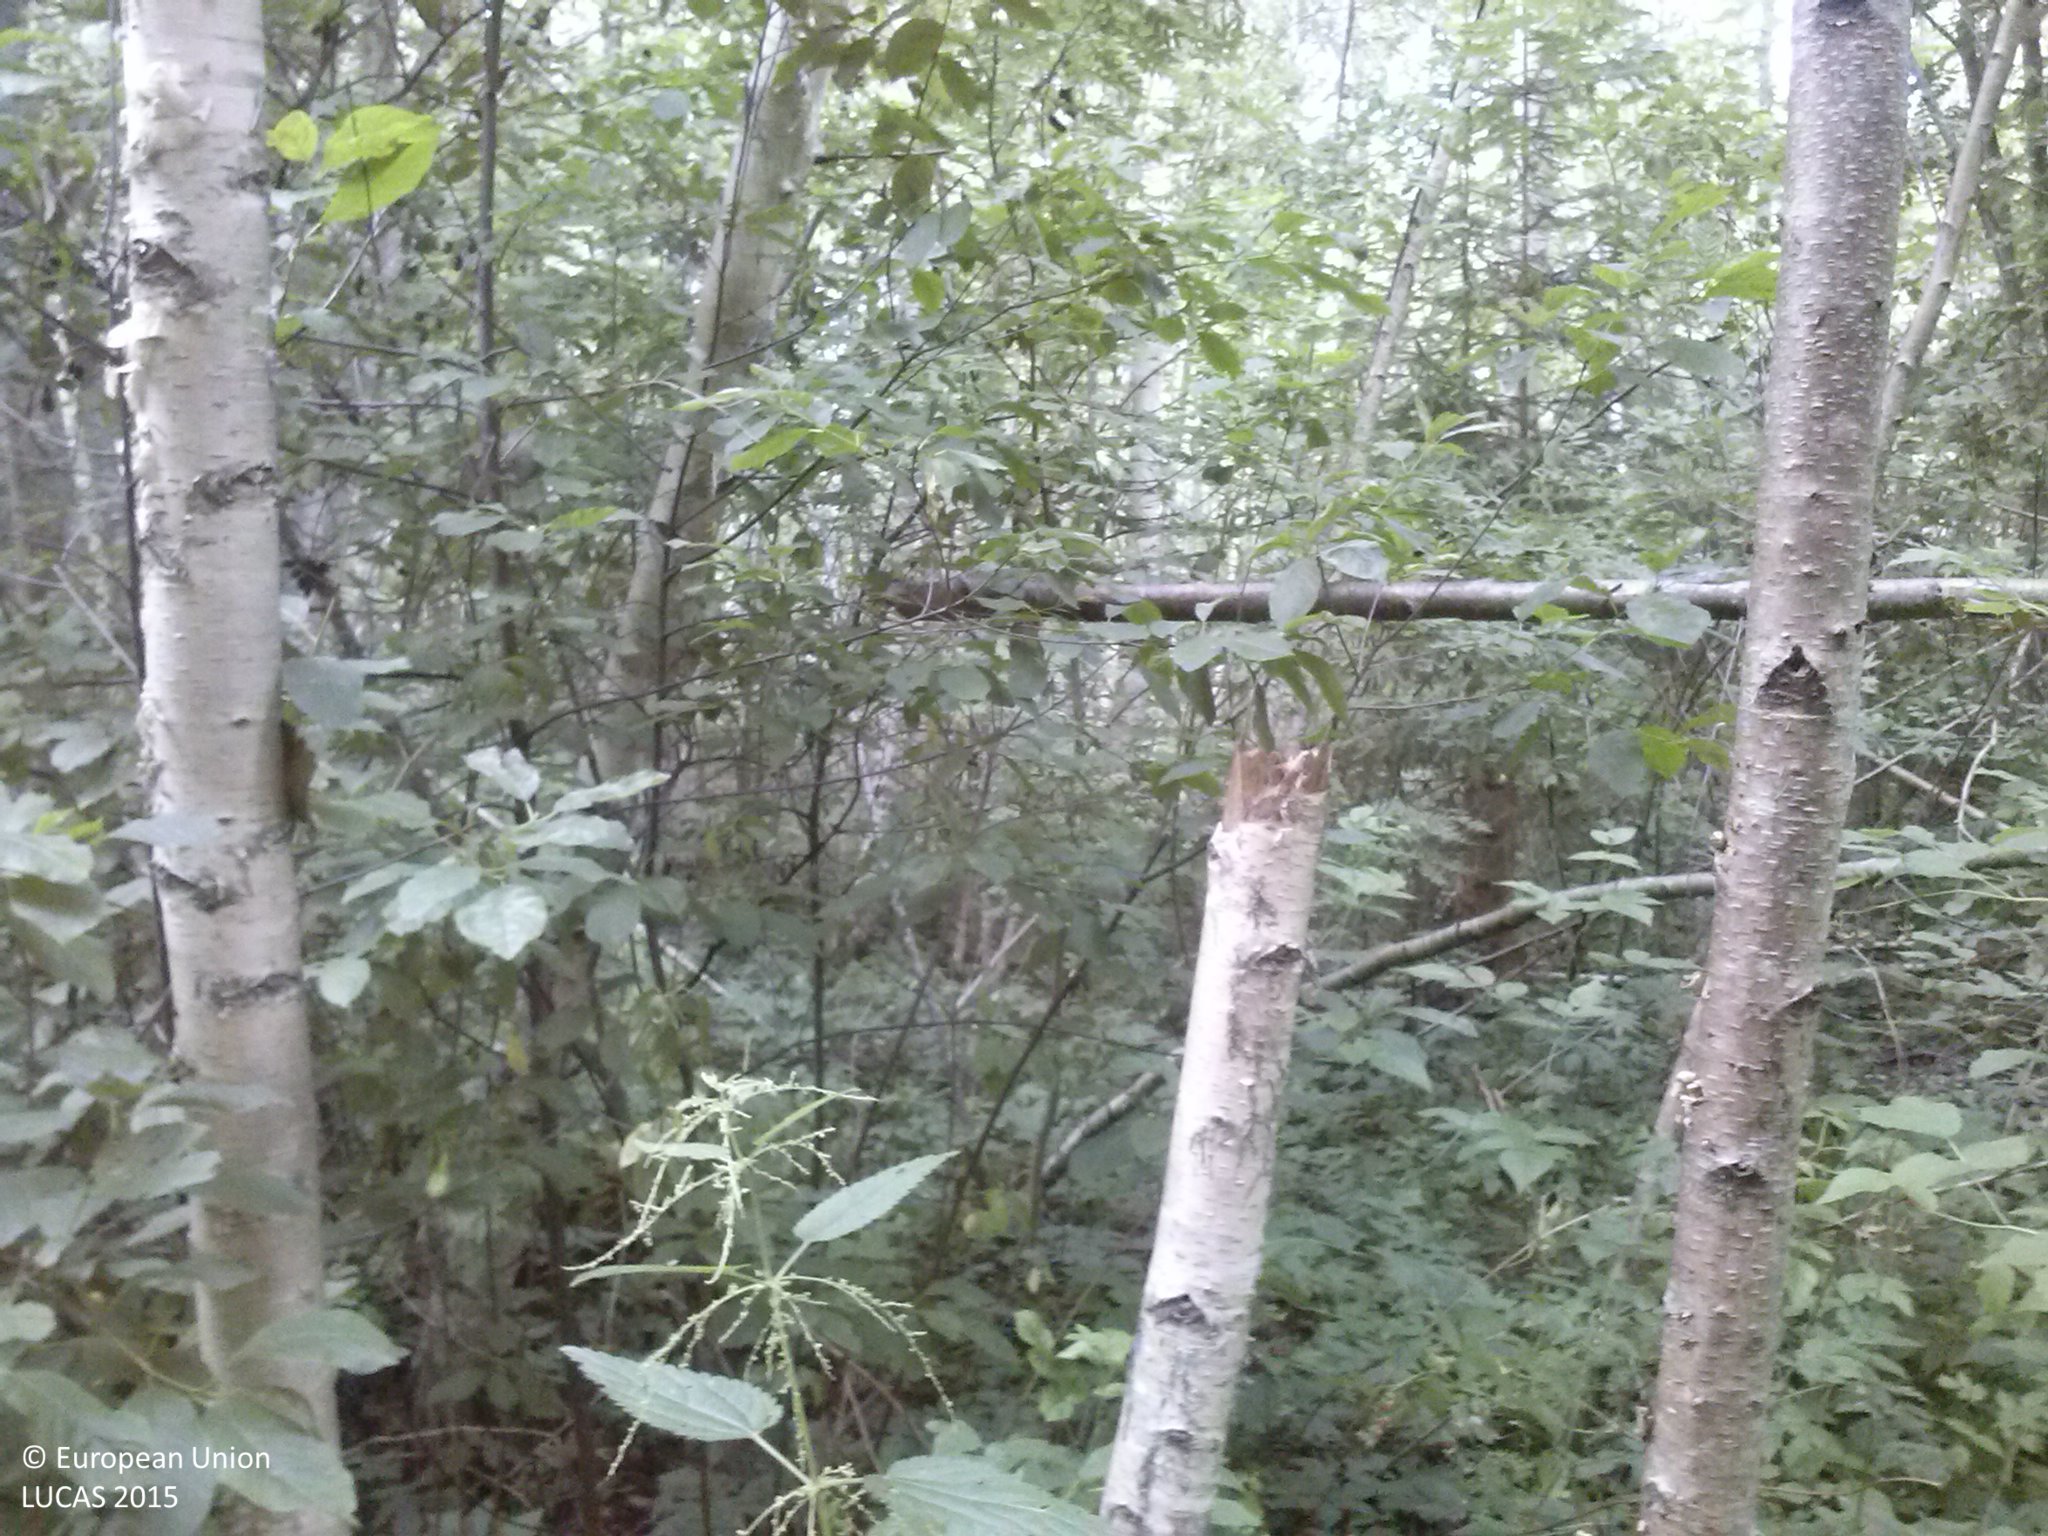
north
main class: Woodland
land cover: Broadleaved woodland
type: non-riverine alder, birch or aspen forest
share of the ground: > 75 %
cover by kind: broadleaved forest trees 75 %, herbaceous plants 15 %, shrubs 10 %
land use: Forestry
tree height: > 5 m
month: July
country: LV
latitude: 56.5562
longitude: 26.9681
